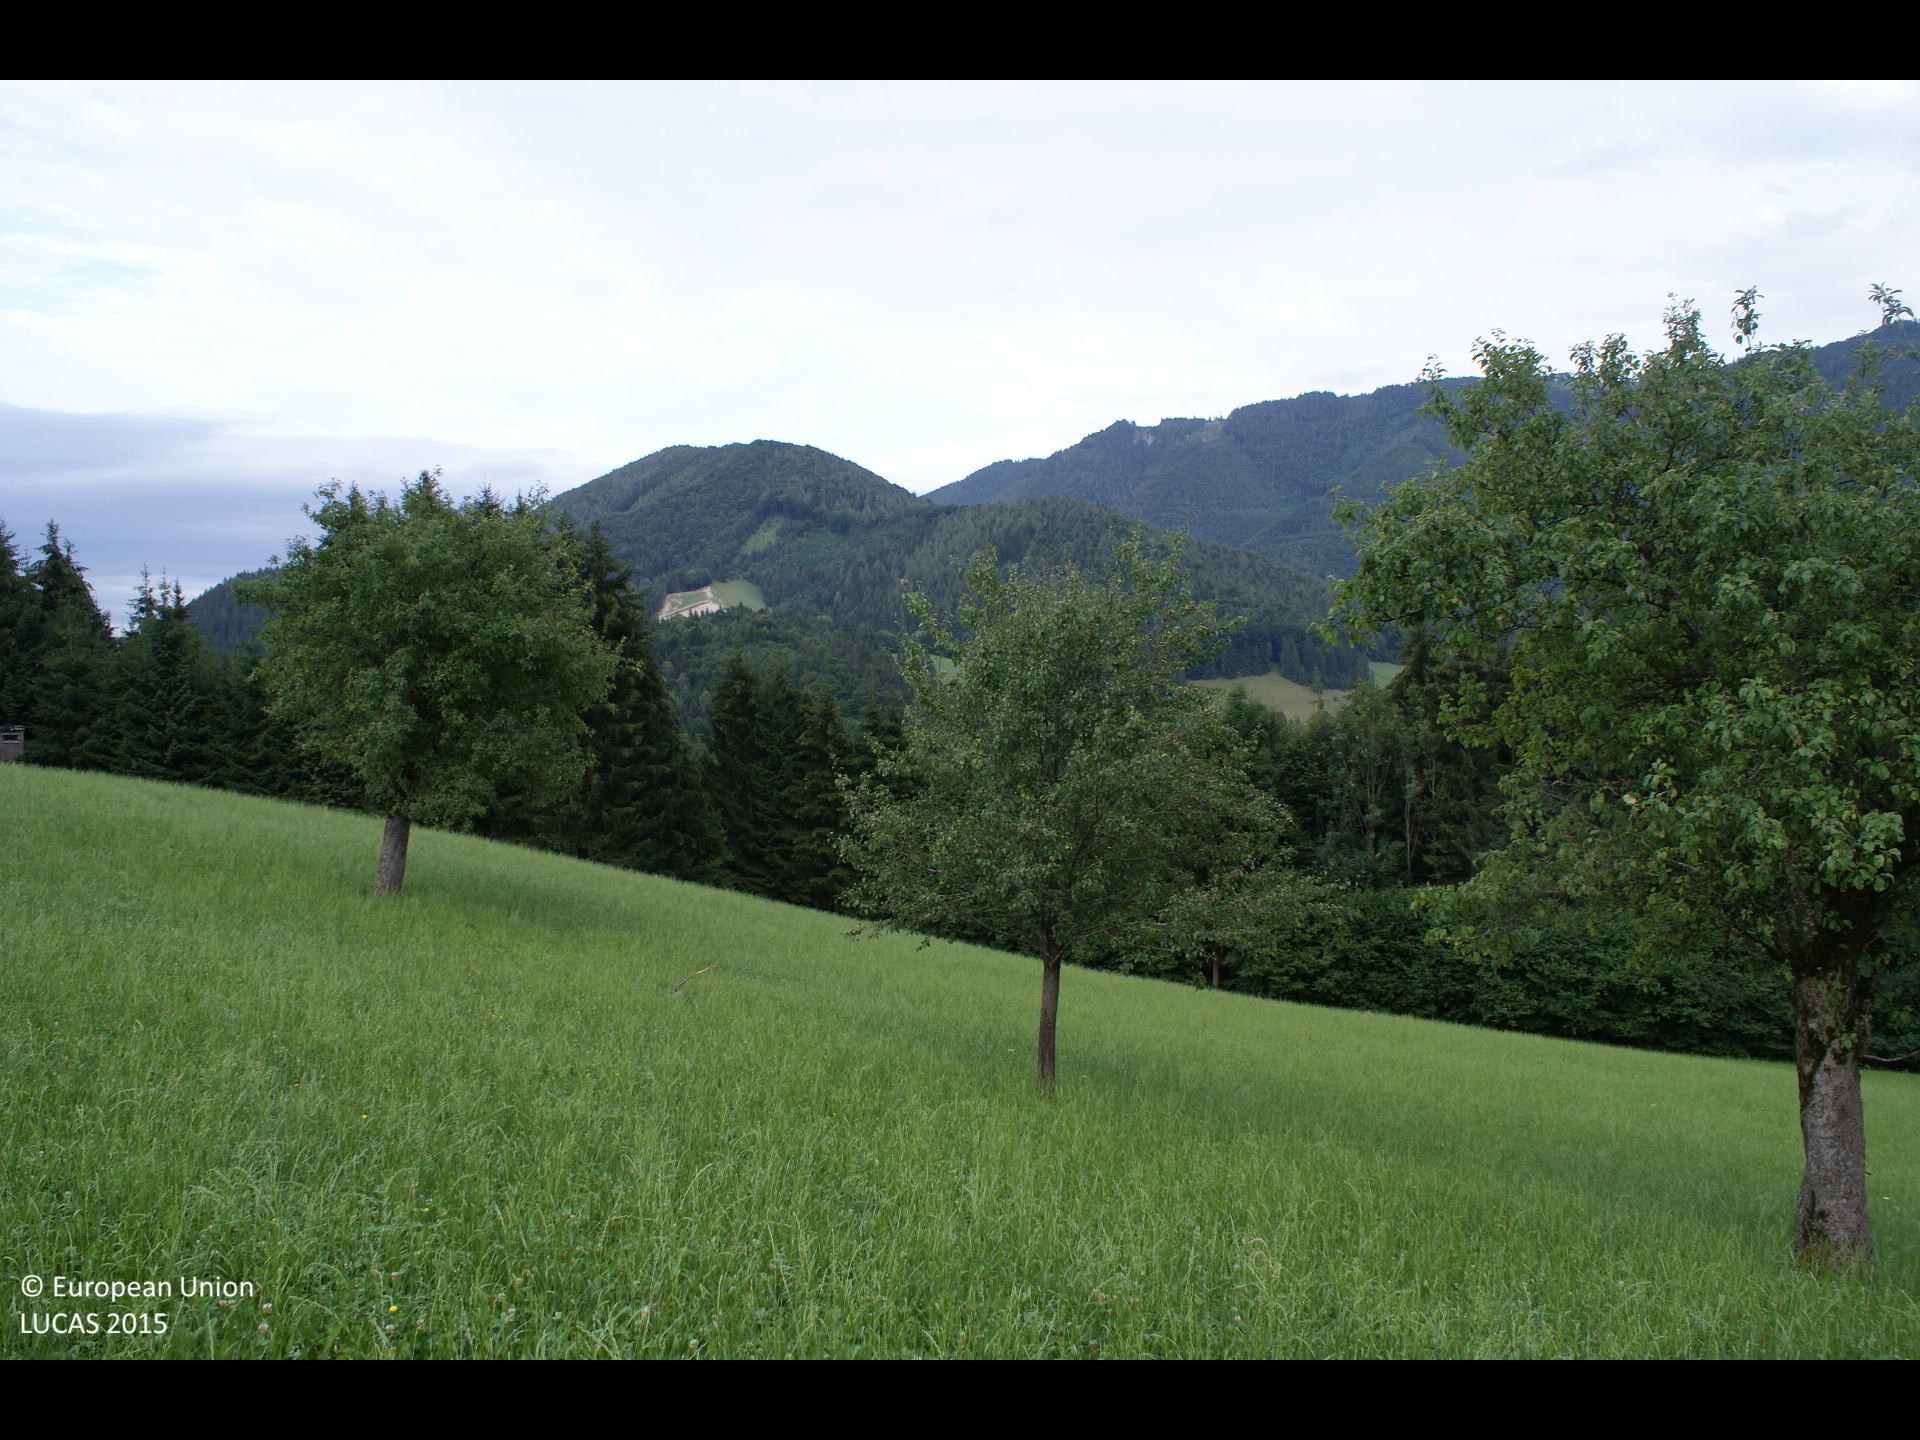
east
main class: Grassland
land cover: Grassland without tree/shrub cover
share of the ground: > 75 %
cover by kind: herbaceous plants 100 %
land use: Agriculture (excluding fallow land and kitchen gardens)
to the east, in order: Grassland without tree/shrub cover; Pear fruit; Grassland without tree/shrub cover; Spruce dominated coniferous woodland; Tracks; Spruce dominated mixed woodland; Tracks; Broadleaved woodland; Fences; Grassland without tree/shrub cover
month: July
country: AT
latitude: 47.9469
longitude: 15.0216
